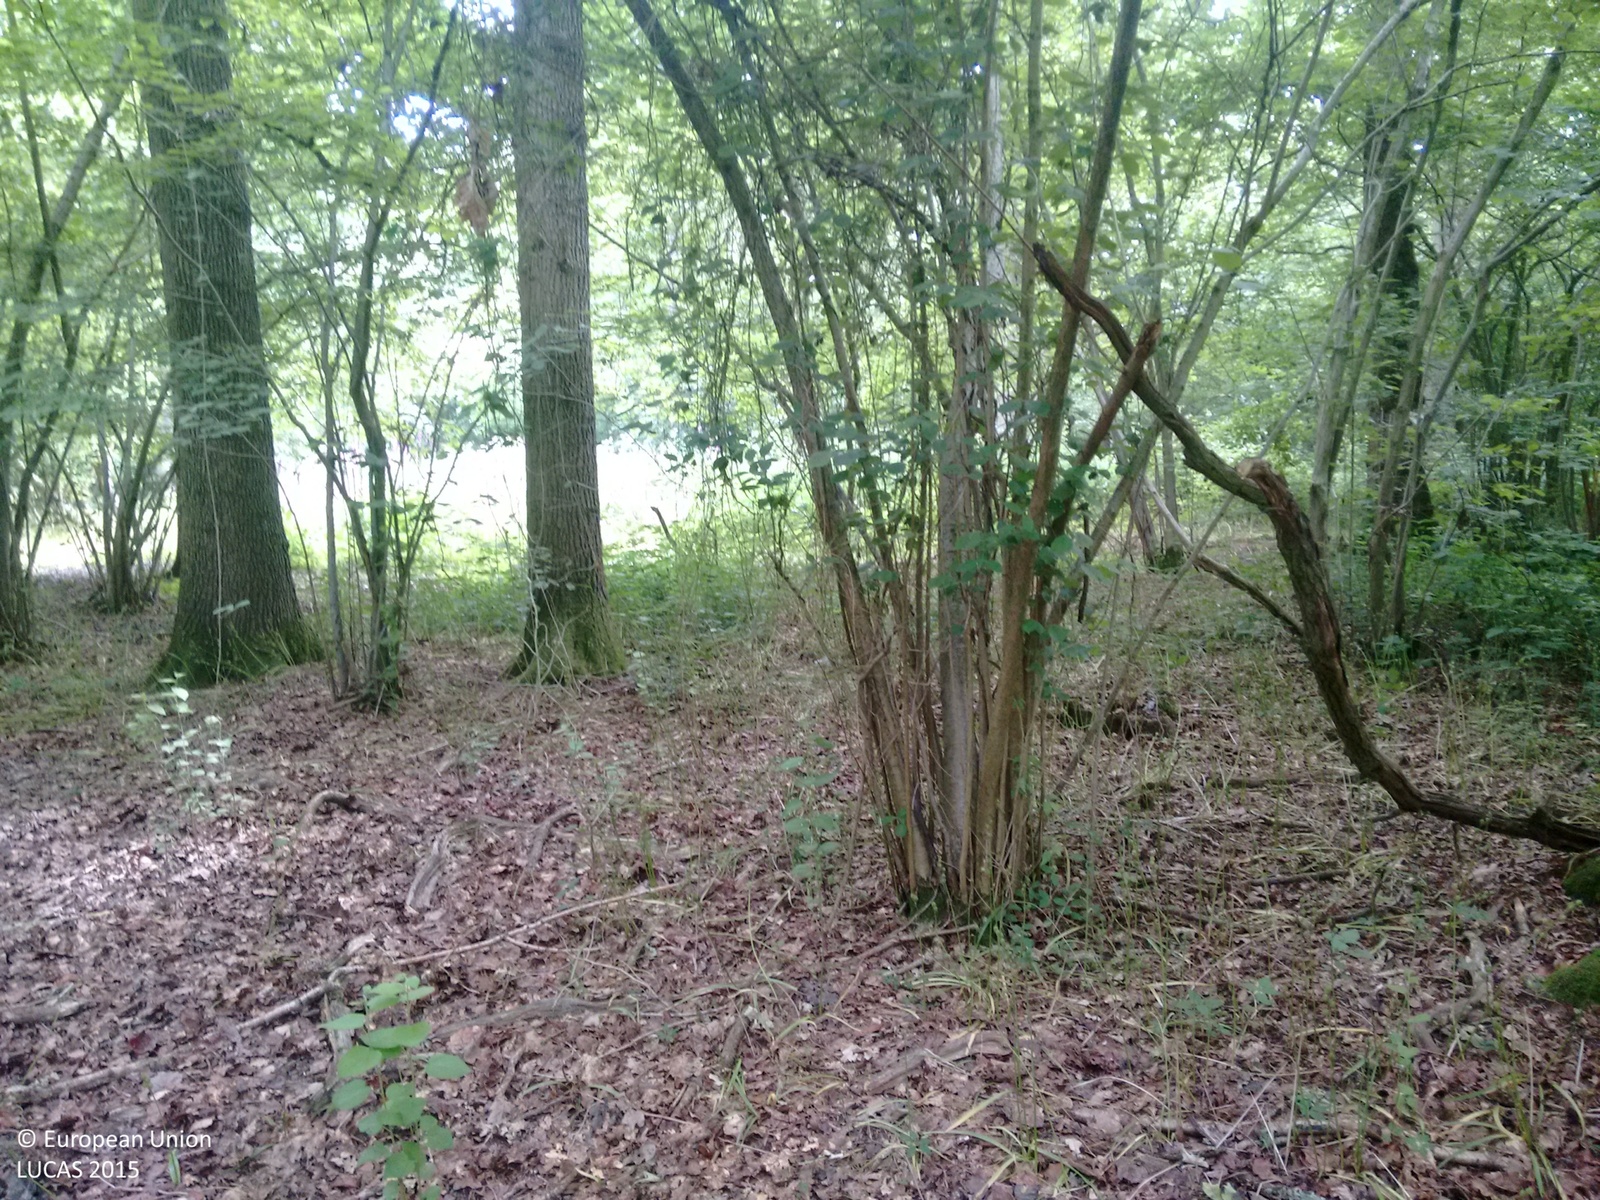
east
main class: Woodland
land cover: Broadleaved woodland
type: mesophytic deciduous forest
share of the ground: > 75 %
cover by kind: broadleaved forest trees 90 %, shrubs 10 %
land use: Semi-natural and natural areas not in use
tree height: > 5 m
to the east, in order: Broadleaved woodland; Fences; Grassland without tree/shrub cover
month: July
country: GB
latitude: 50.9541
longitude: -0.0408
